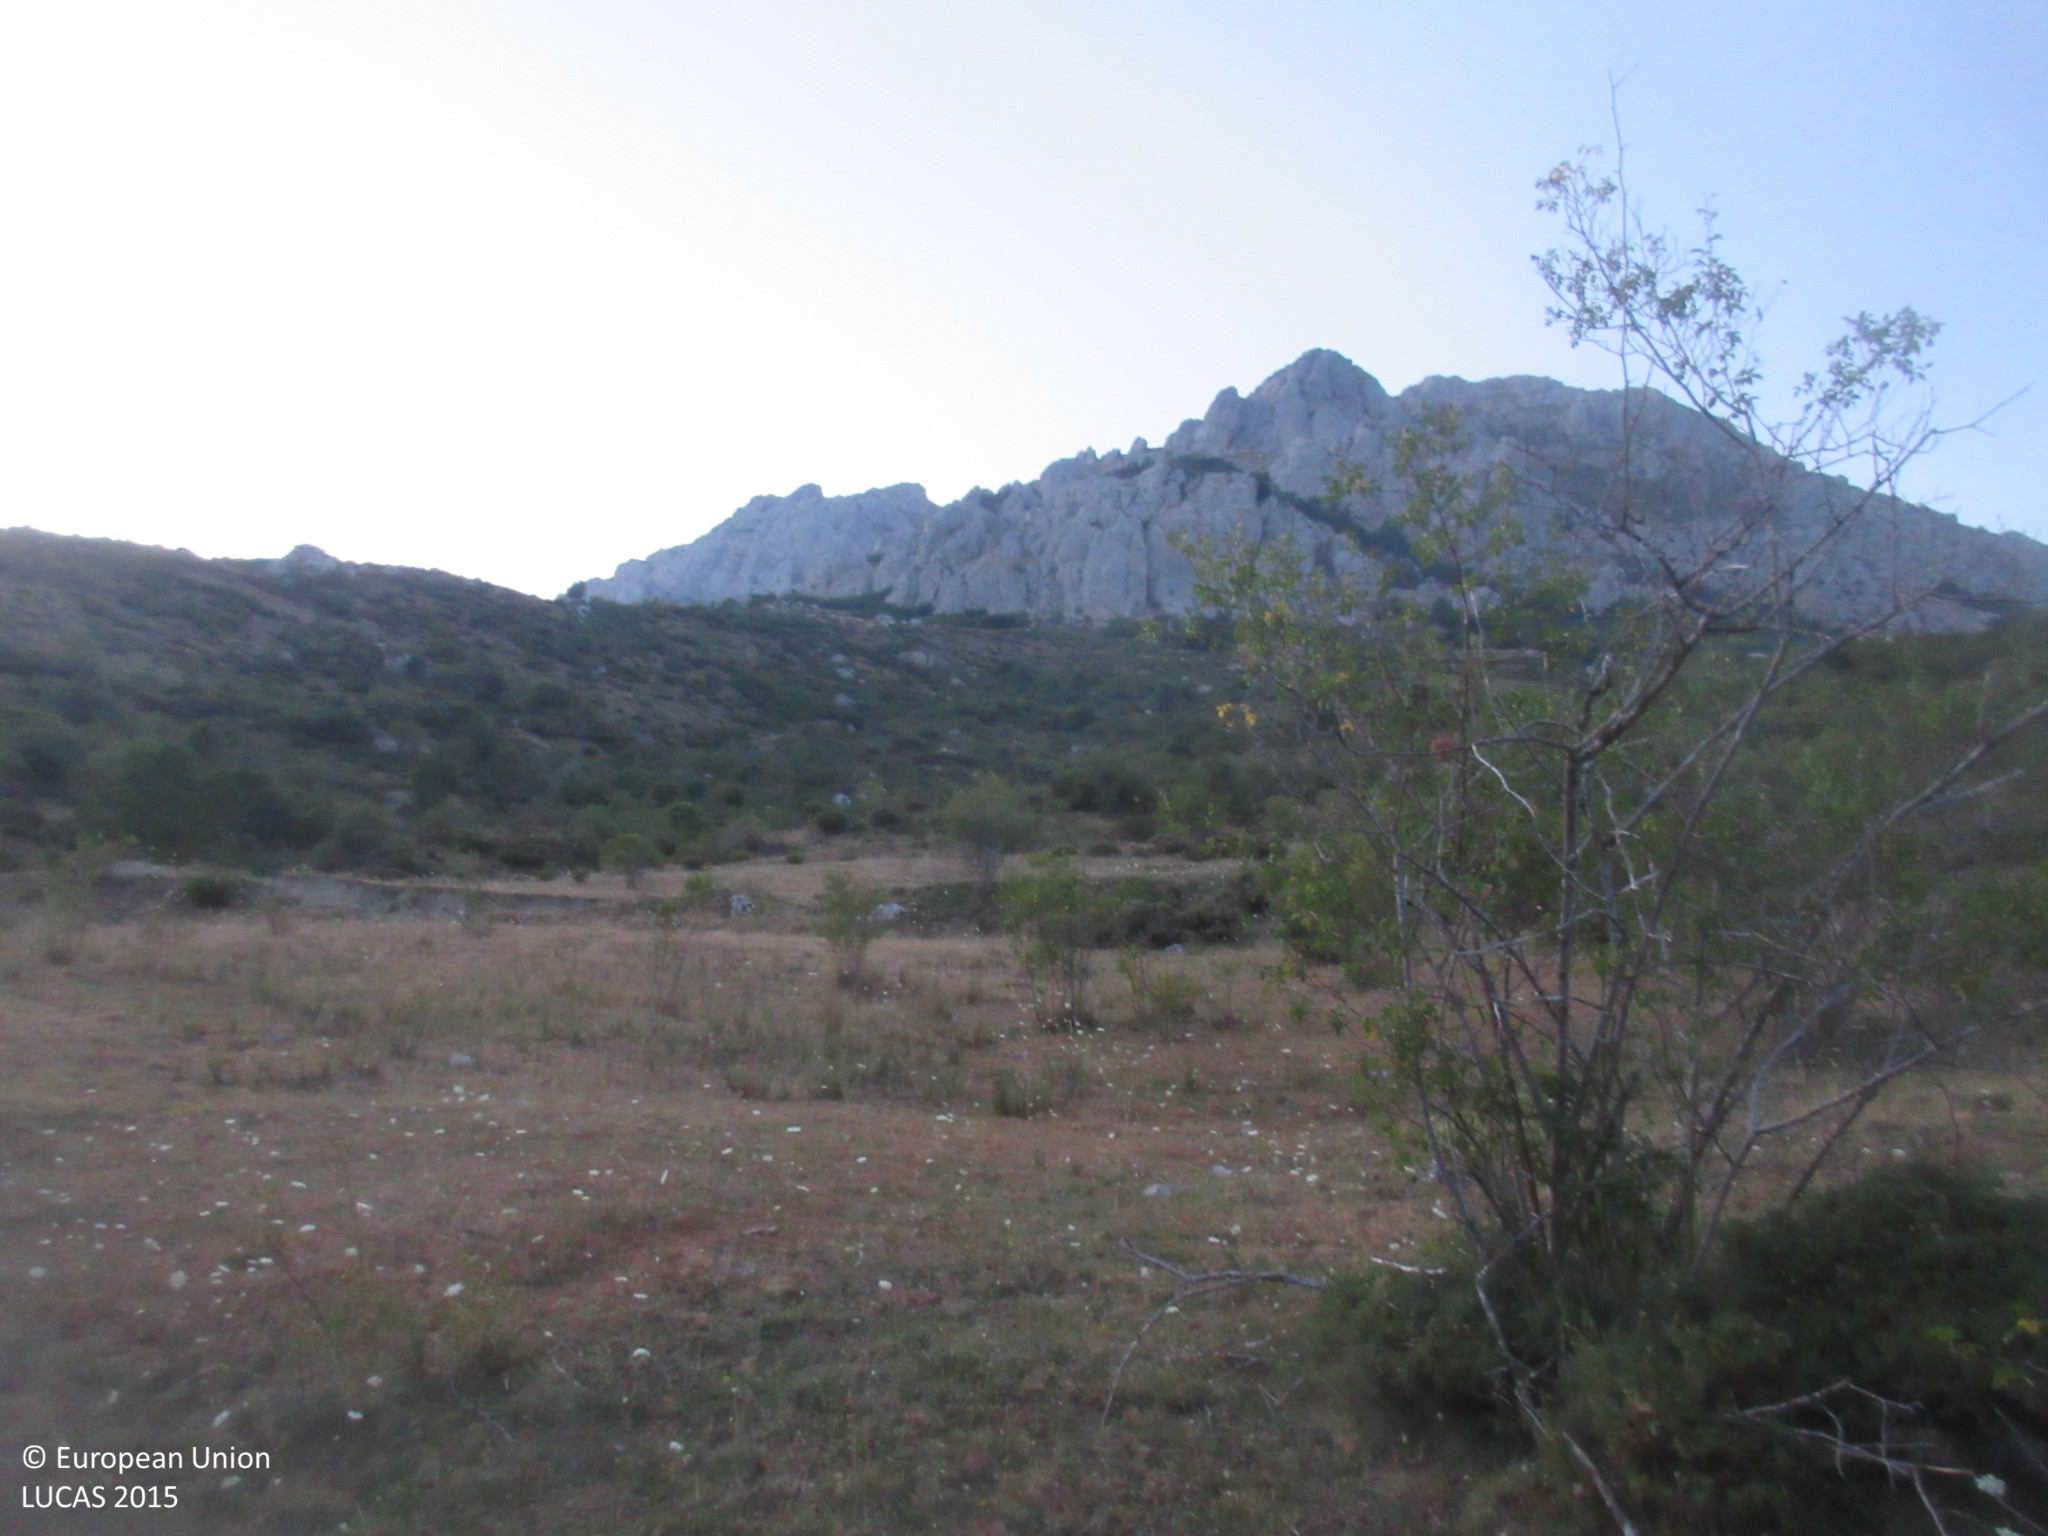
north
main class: Grassland
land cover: Grassland without tree/shrub cover
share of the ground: > 75 %
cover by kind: herbaceous plants 100 %
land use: Agriculture (excluding fallow land and kitchen gardens)
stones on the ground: < 10 %
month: July
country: ES
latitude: 42.9458
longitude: -5.4557
